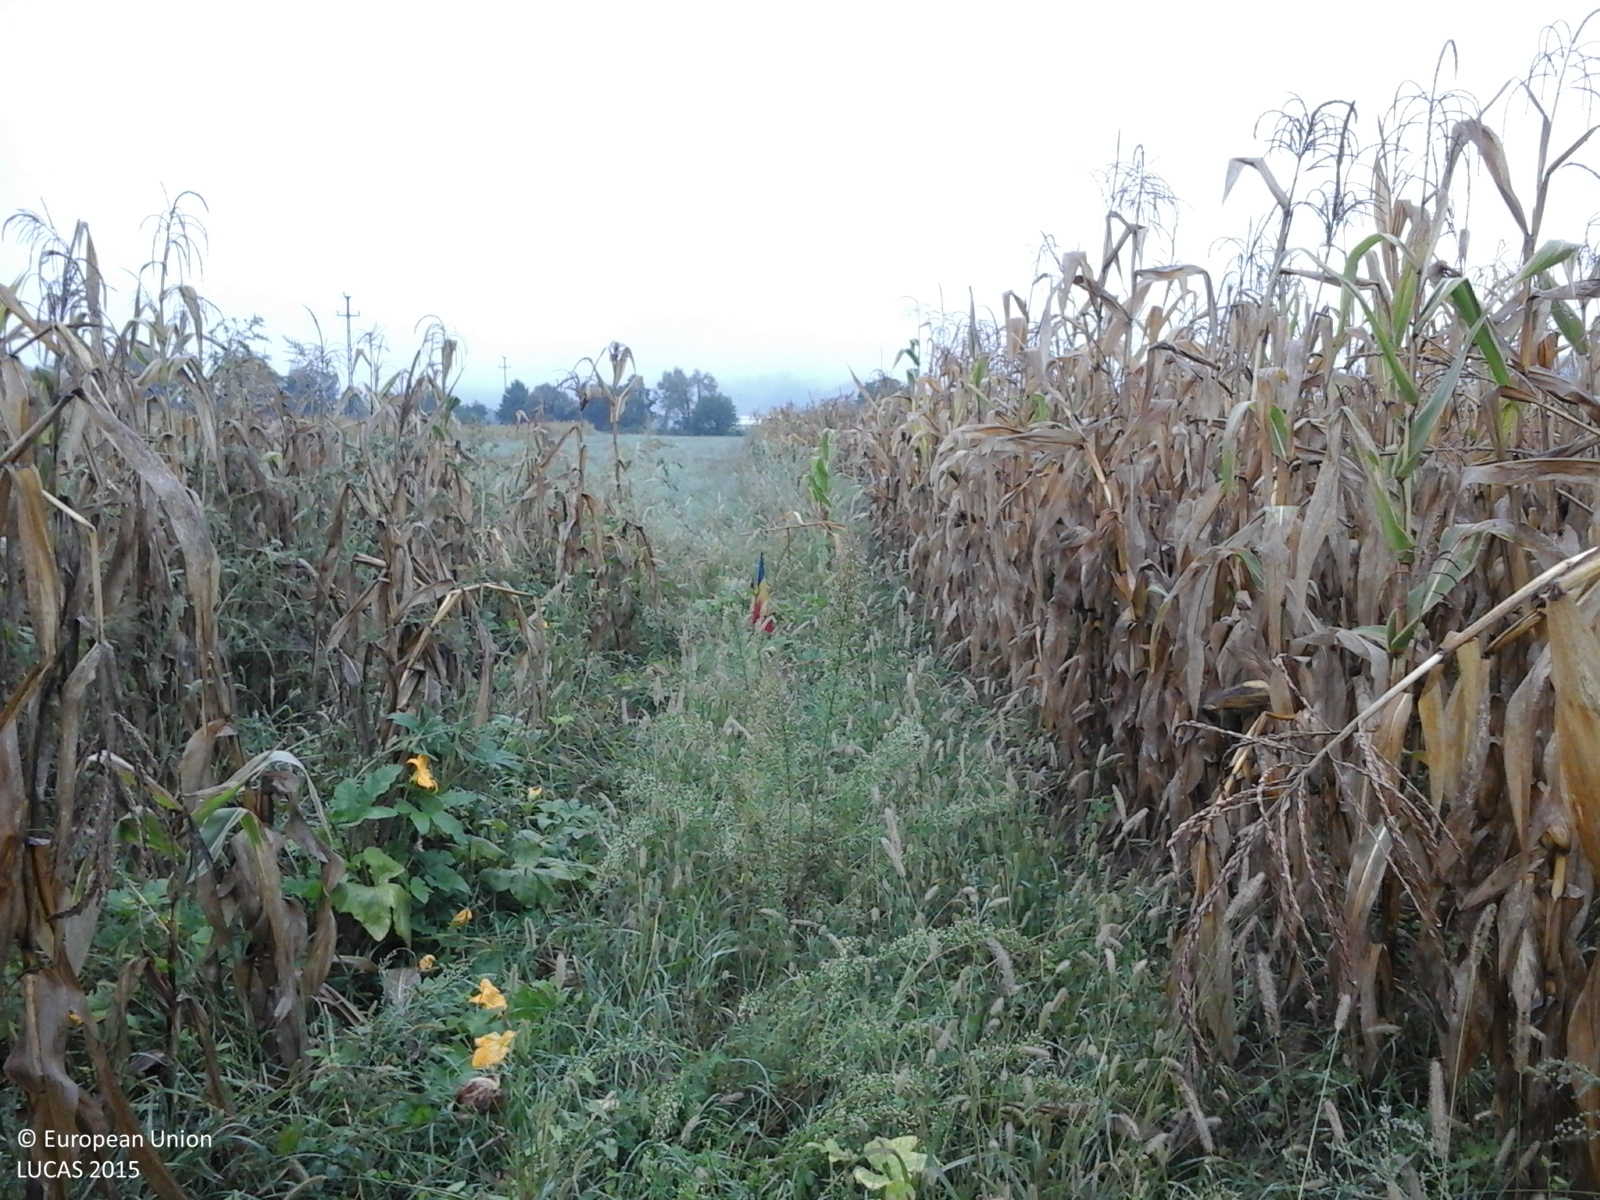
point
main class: Cropland
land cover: Maize
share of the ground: > 75 %
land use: Agriculture (excluding fallow land and kitchen gardens)
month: September
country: RO
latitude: 47.0364
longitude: 22.4906
